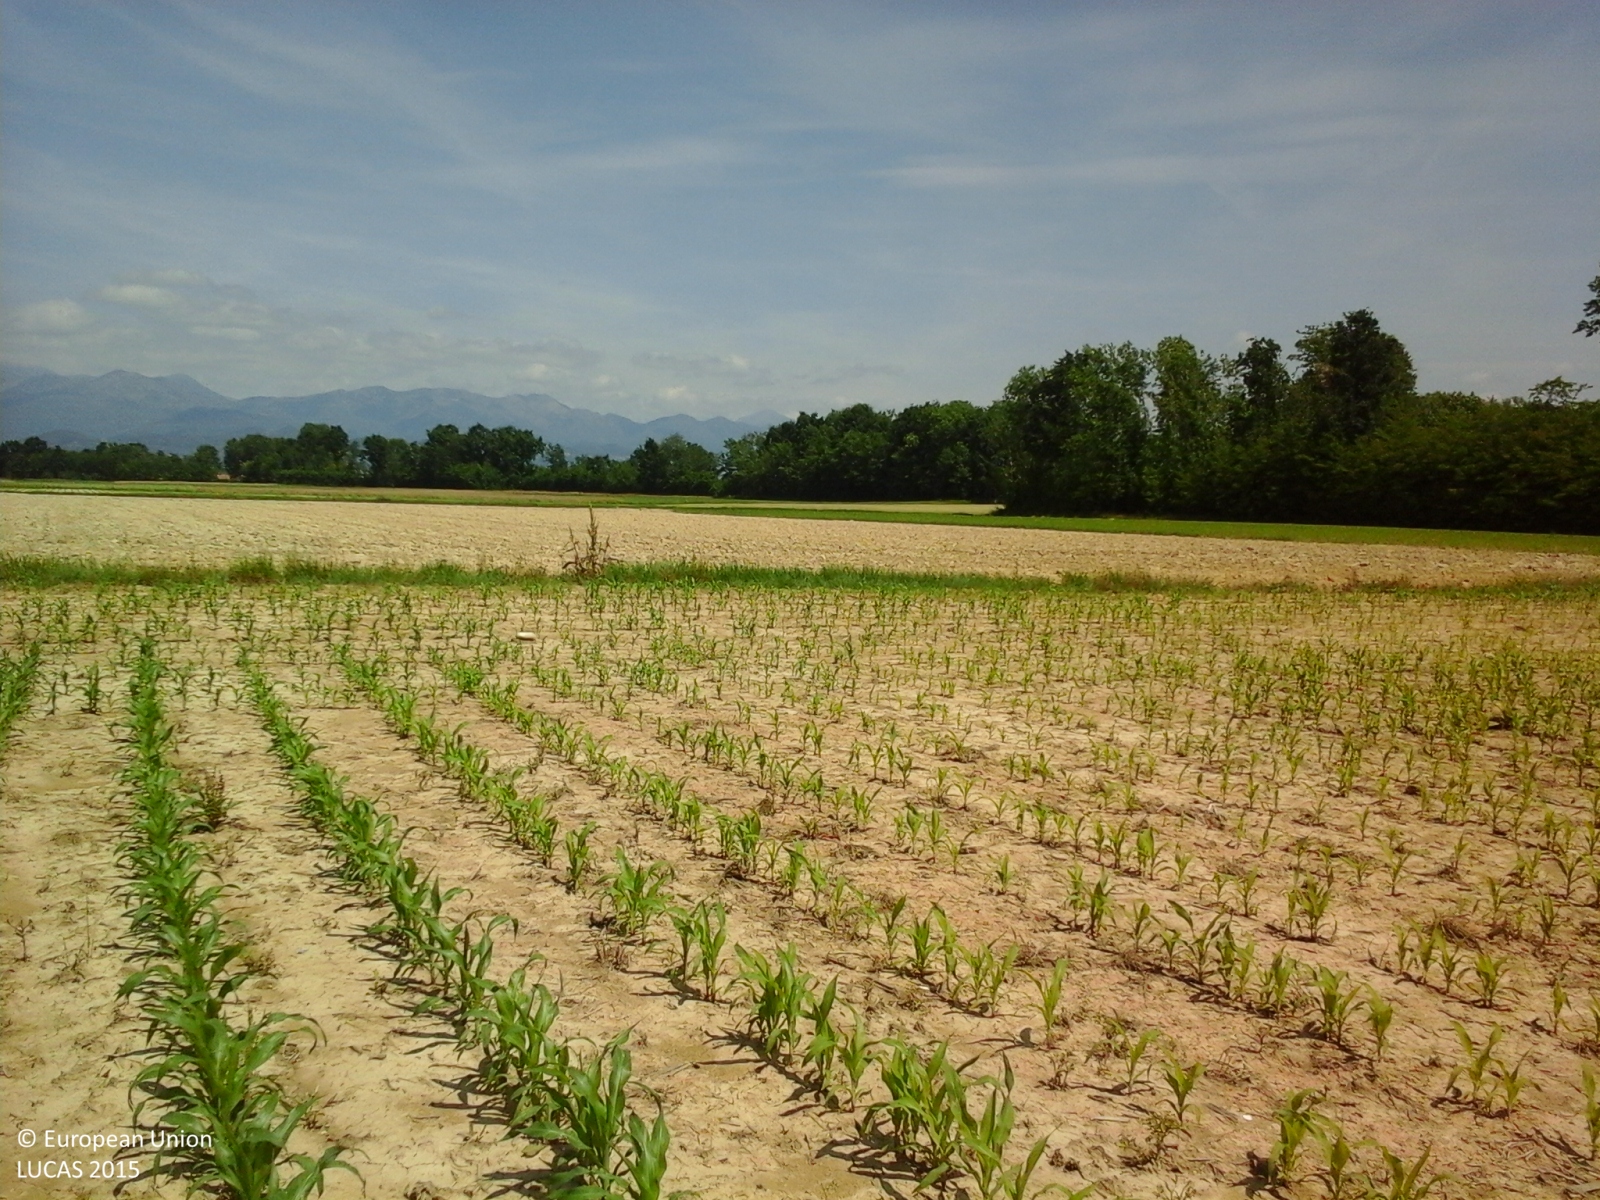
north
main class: Cropland
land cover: Maize
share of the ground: 10 - 25 %
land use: Agriculture (excluding fallow land and kitchen gardens)
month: May
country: IT
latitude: 45.5053
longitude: 8.0960
